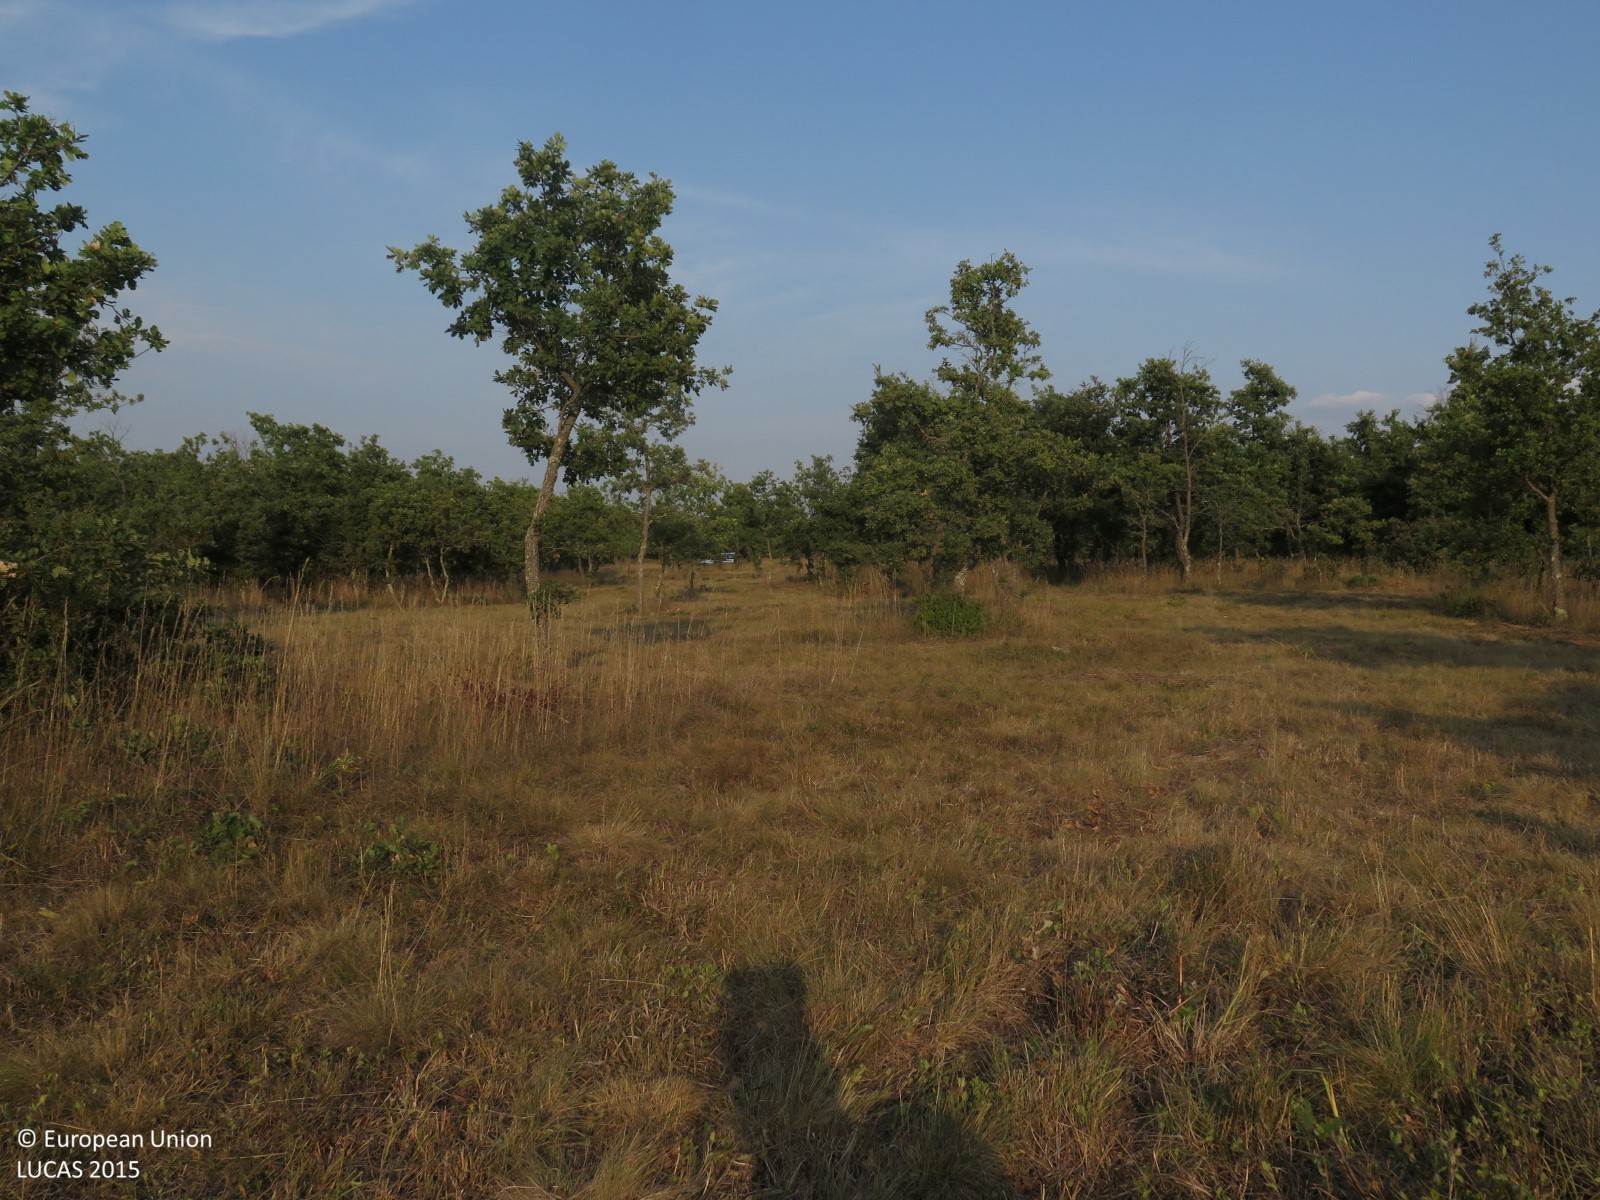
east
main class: Grassland
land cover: Grassland with sparse tree/shrub cover
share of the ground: > 75 %
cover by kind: herbaceous plants 85 %, shrubs 10 %, broadleaved forest trees 5 %
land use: Semi-natural and natural areas not in use
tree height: < 5 m
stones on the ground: < 10 %
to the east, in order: Grassland with sparse tree/shrub cover; Rocks and stones; Grassland with sparse tree/shrub cover; Tracks; Grassland with sparse tree/shrub cover; Shrubland with sparse tree cover; Broadleaved woodland
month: July
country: HR
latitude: 45.2573
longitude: 13.7541
